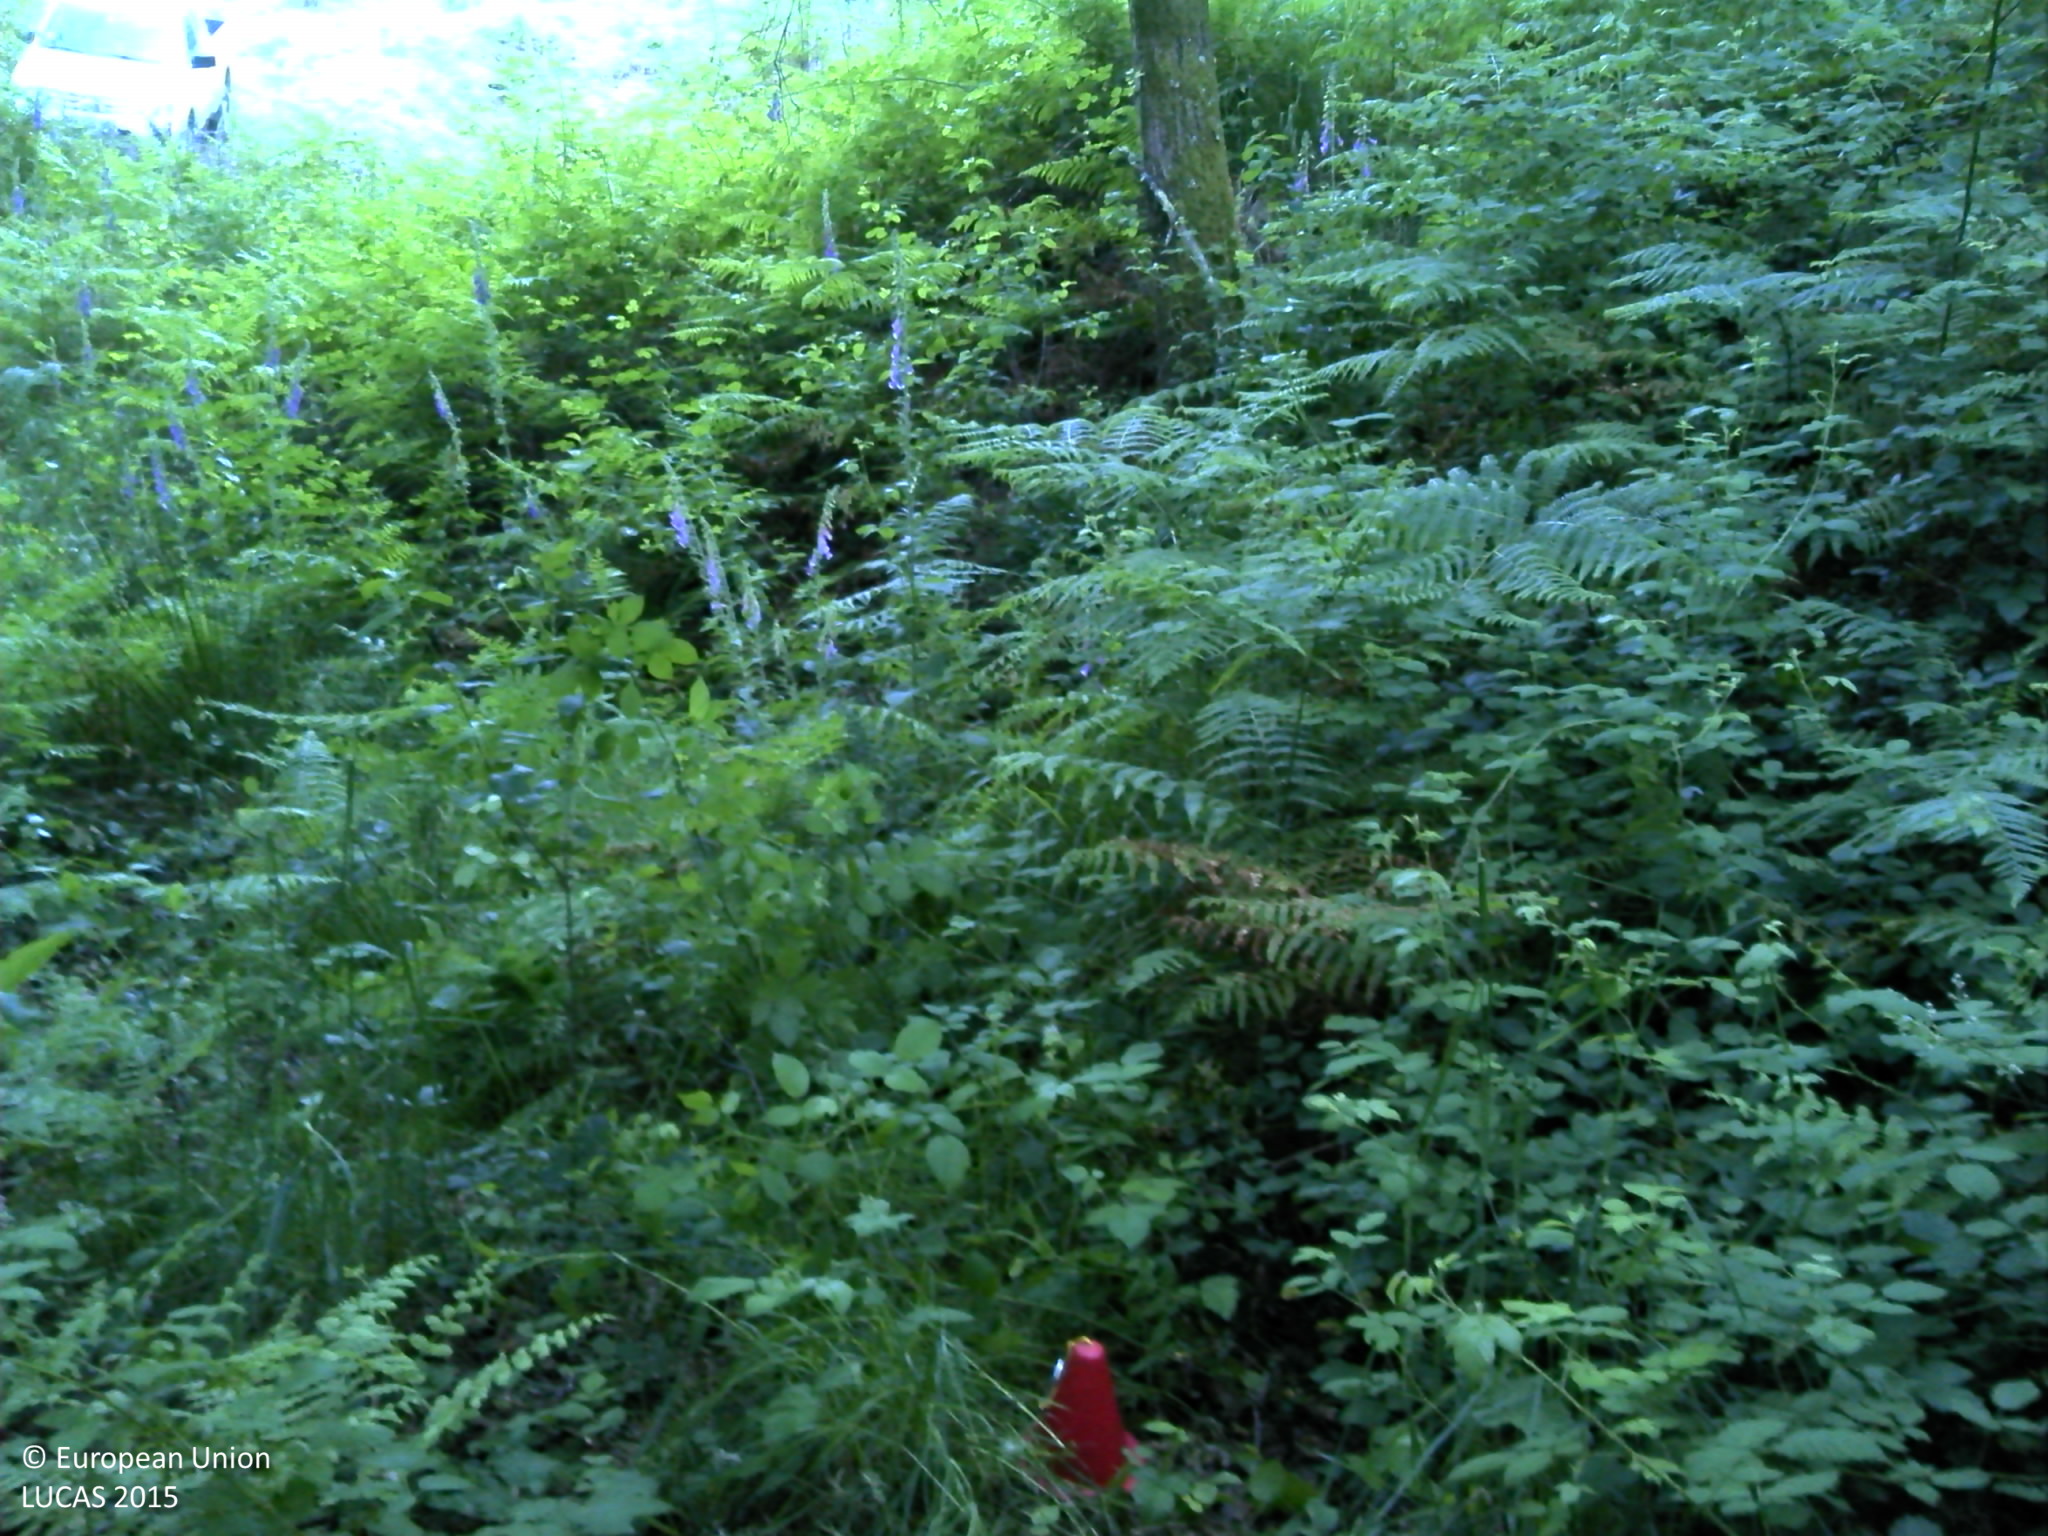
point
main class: Woodland
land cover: Broadleaved woodland
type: acidophilous oak and oak-birch forest
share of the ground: 50 - 75 %
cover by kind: broadleaved forest trees 75 %, shrubs 20 %, herbaceous plants 5 %
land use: Forestry
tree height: > 5 m
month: May
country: PT
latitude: 41.9375
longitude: -8.6567
